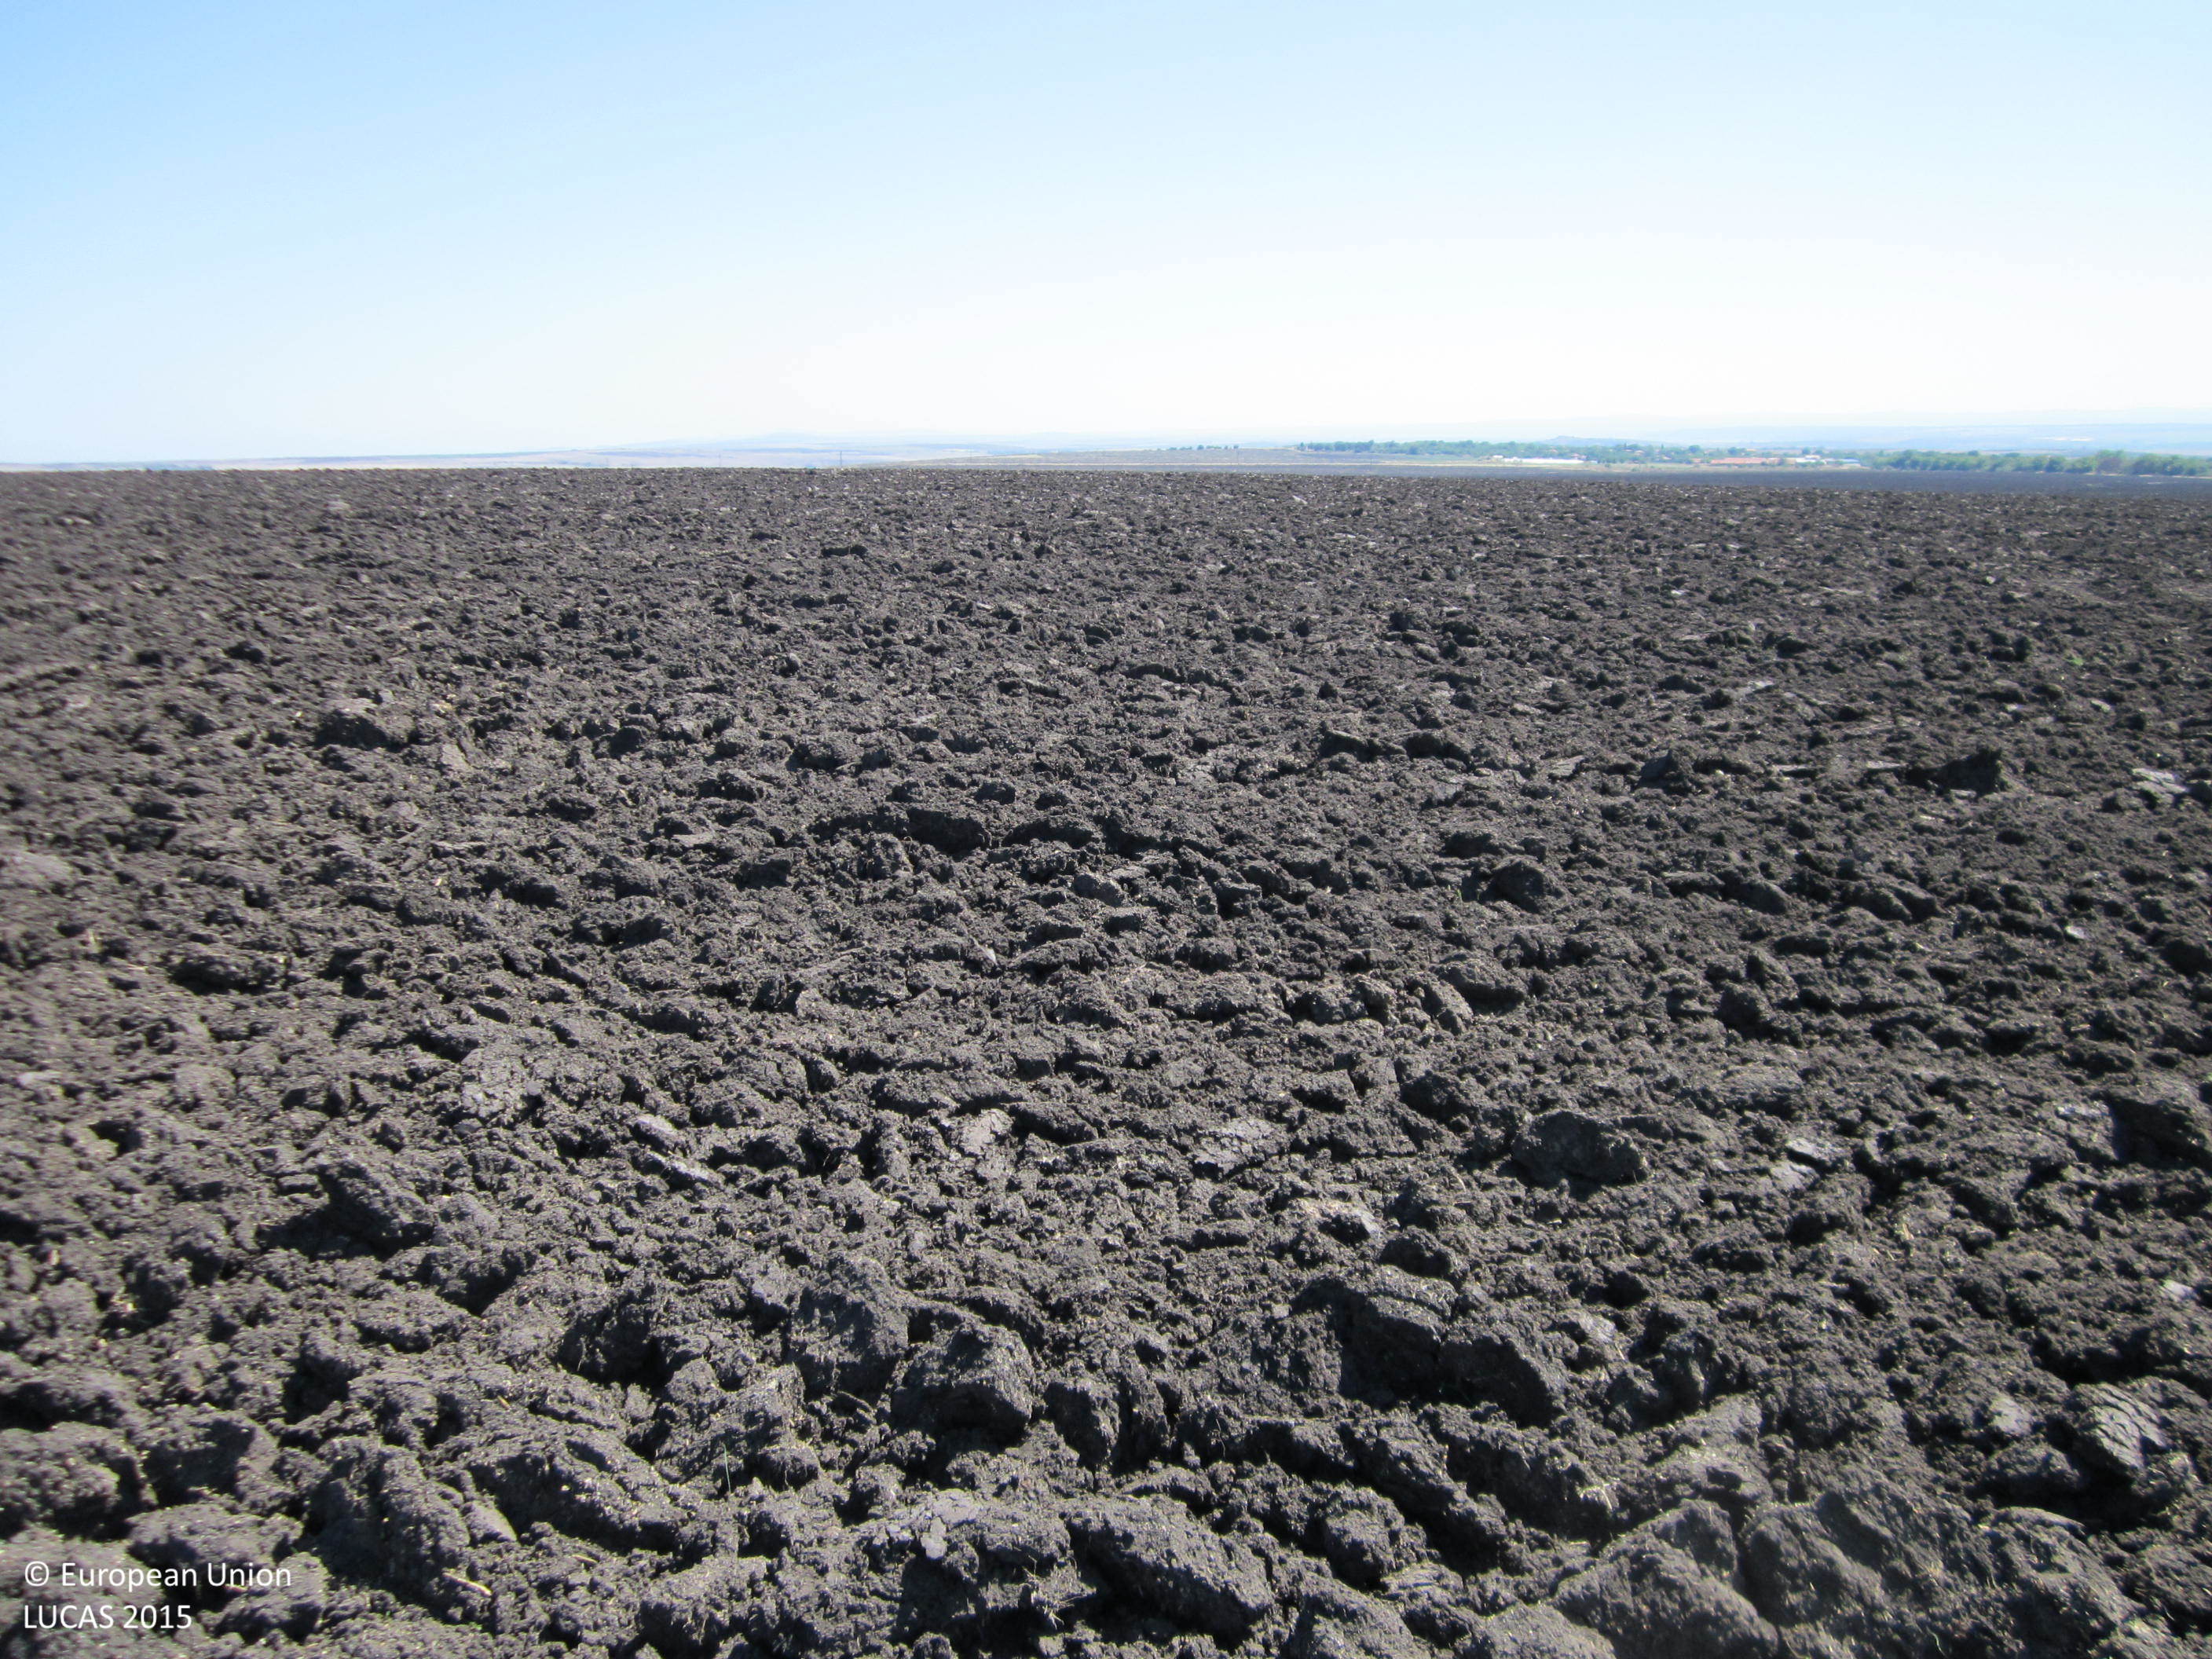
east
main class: Cropland
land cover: Common wheat
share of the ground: < 10 %
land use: Agriculture (excluding fallow land and kitchen gardens)
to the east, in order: Common wheat
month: September
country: BG
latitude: 42.5331
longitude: 27.0915
